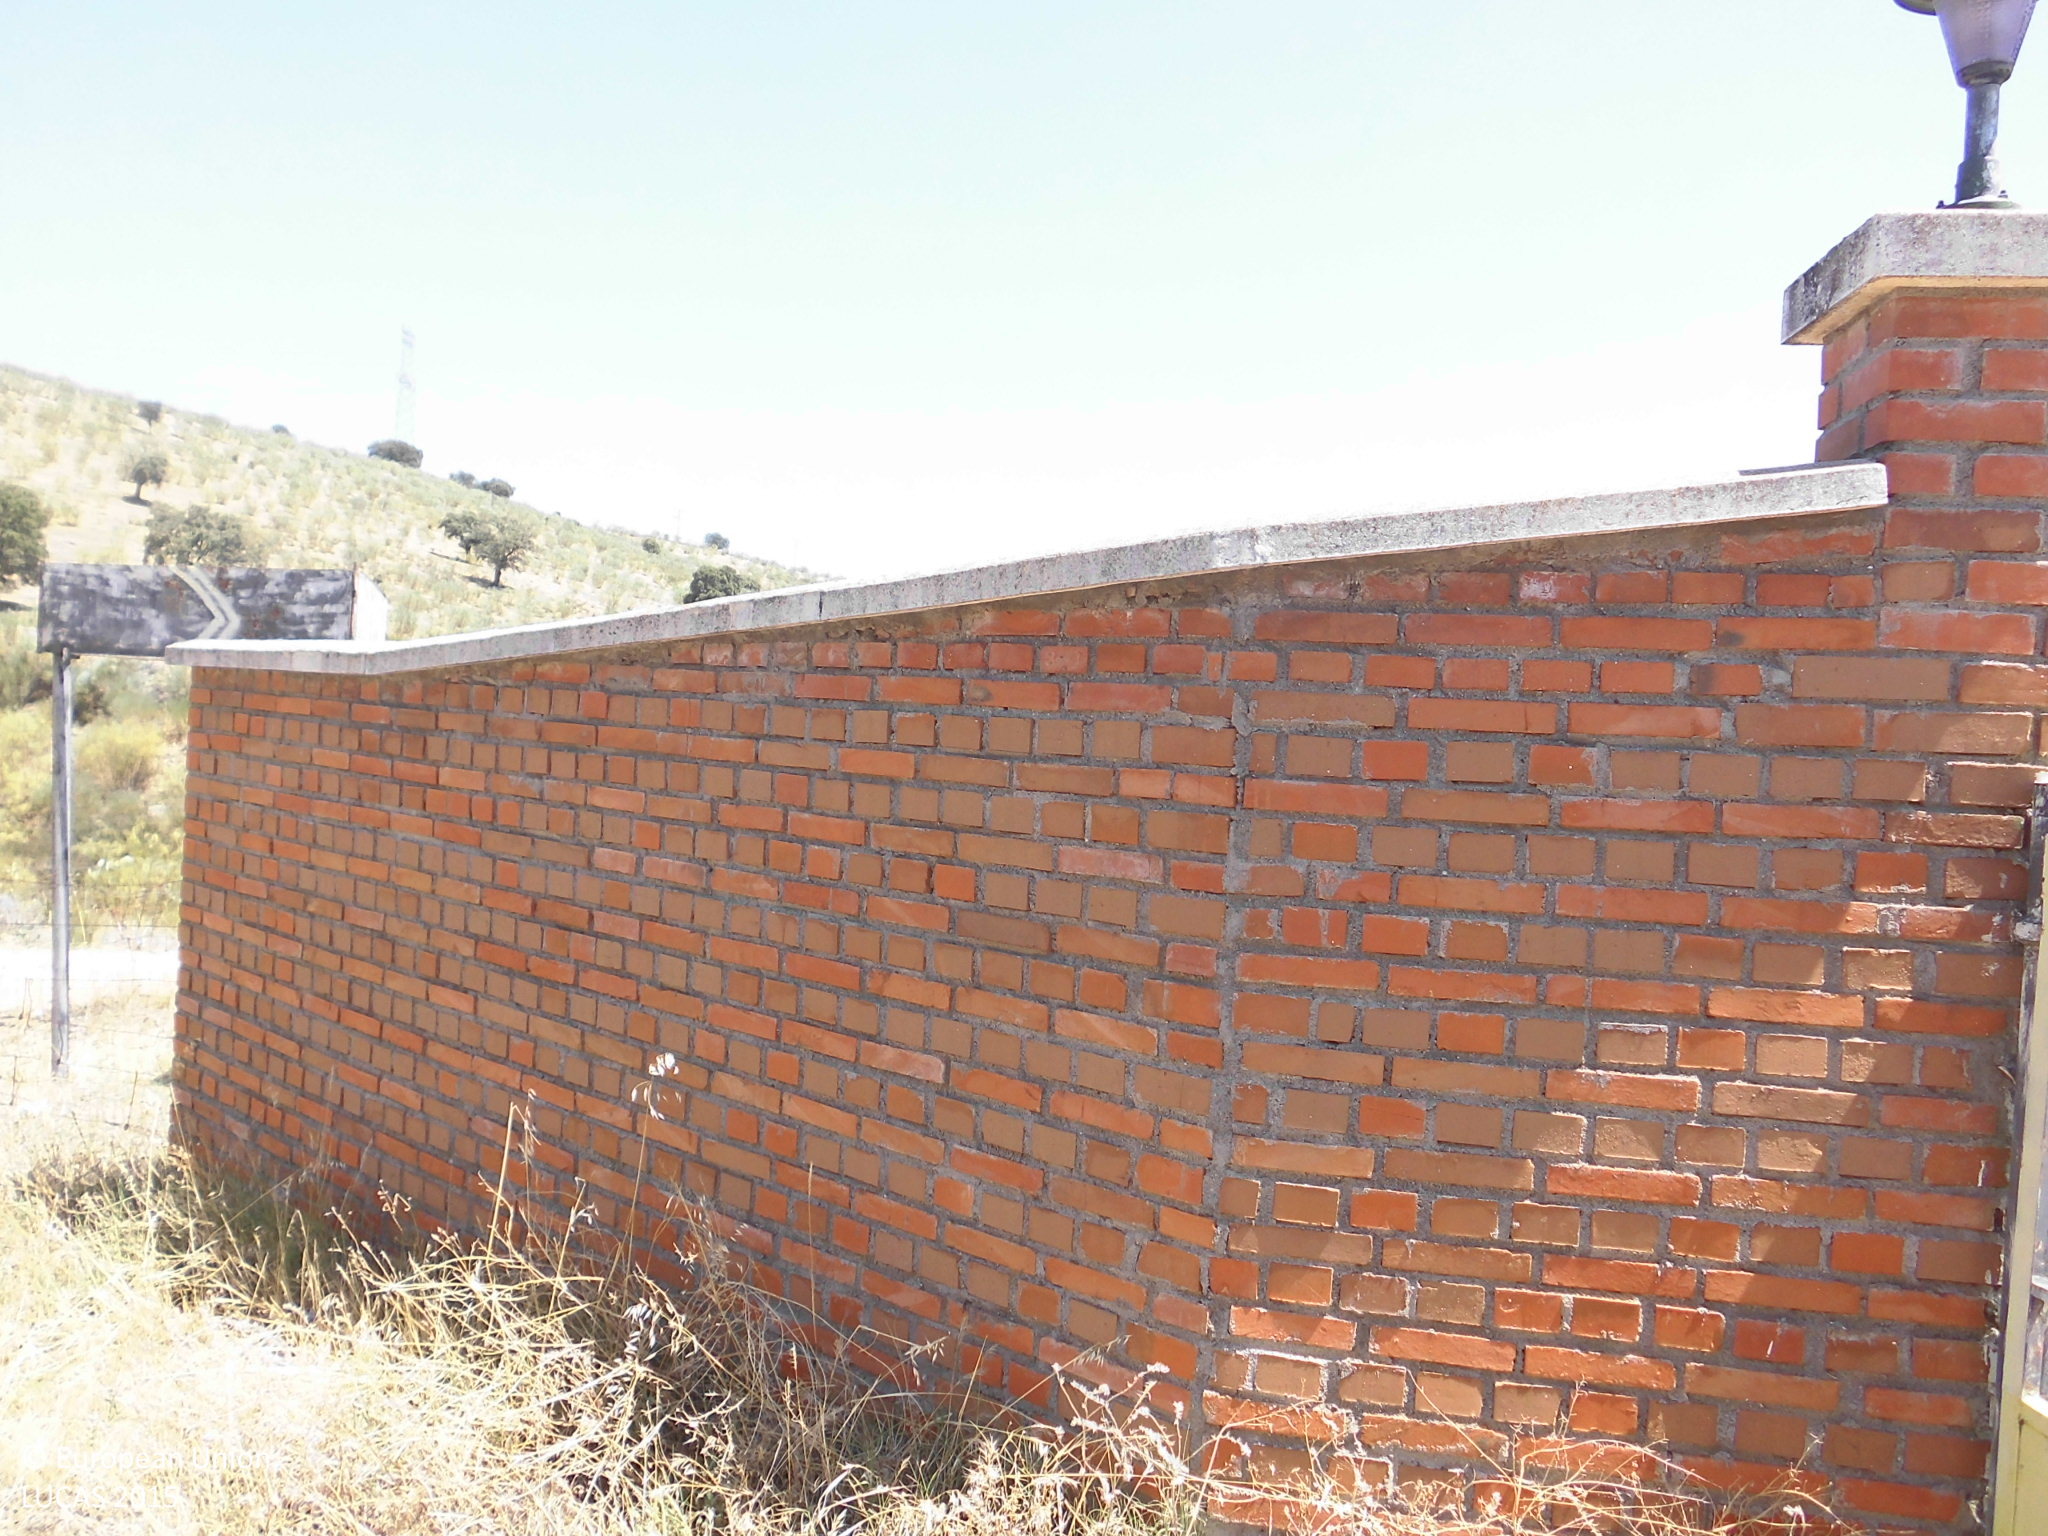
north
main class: Woodland
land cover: Broadleaved woodland
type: broadleaved evergreen forest
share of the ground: 25 - 50 %
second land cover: Grassland without tree/shrub cover
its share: > 75 %
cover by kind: herbaceous plants 60 %, broadleaved forest trees 25 %, shrubs 15 %
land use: Forestry
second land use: Agriculture (excluding fallow land and kitchen gardens)
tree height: > 5 m
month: July
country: ES
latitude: 39.7559
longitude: -5.4265
